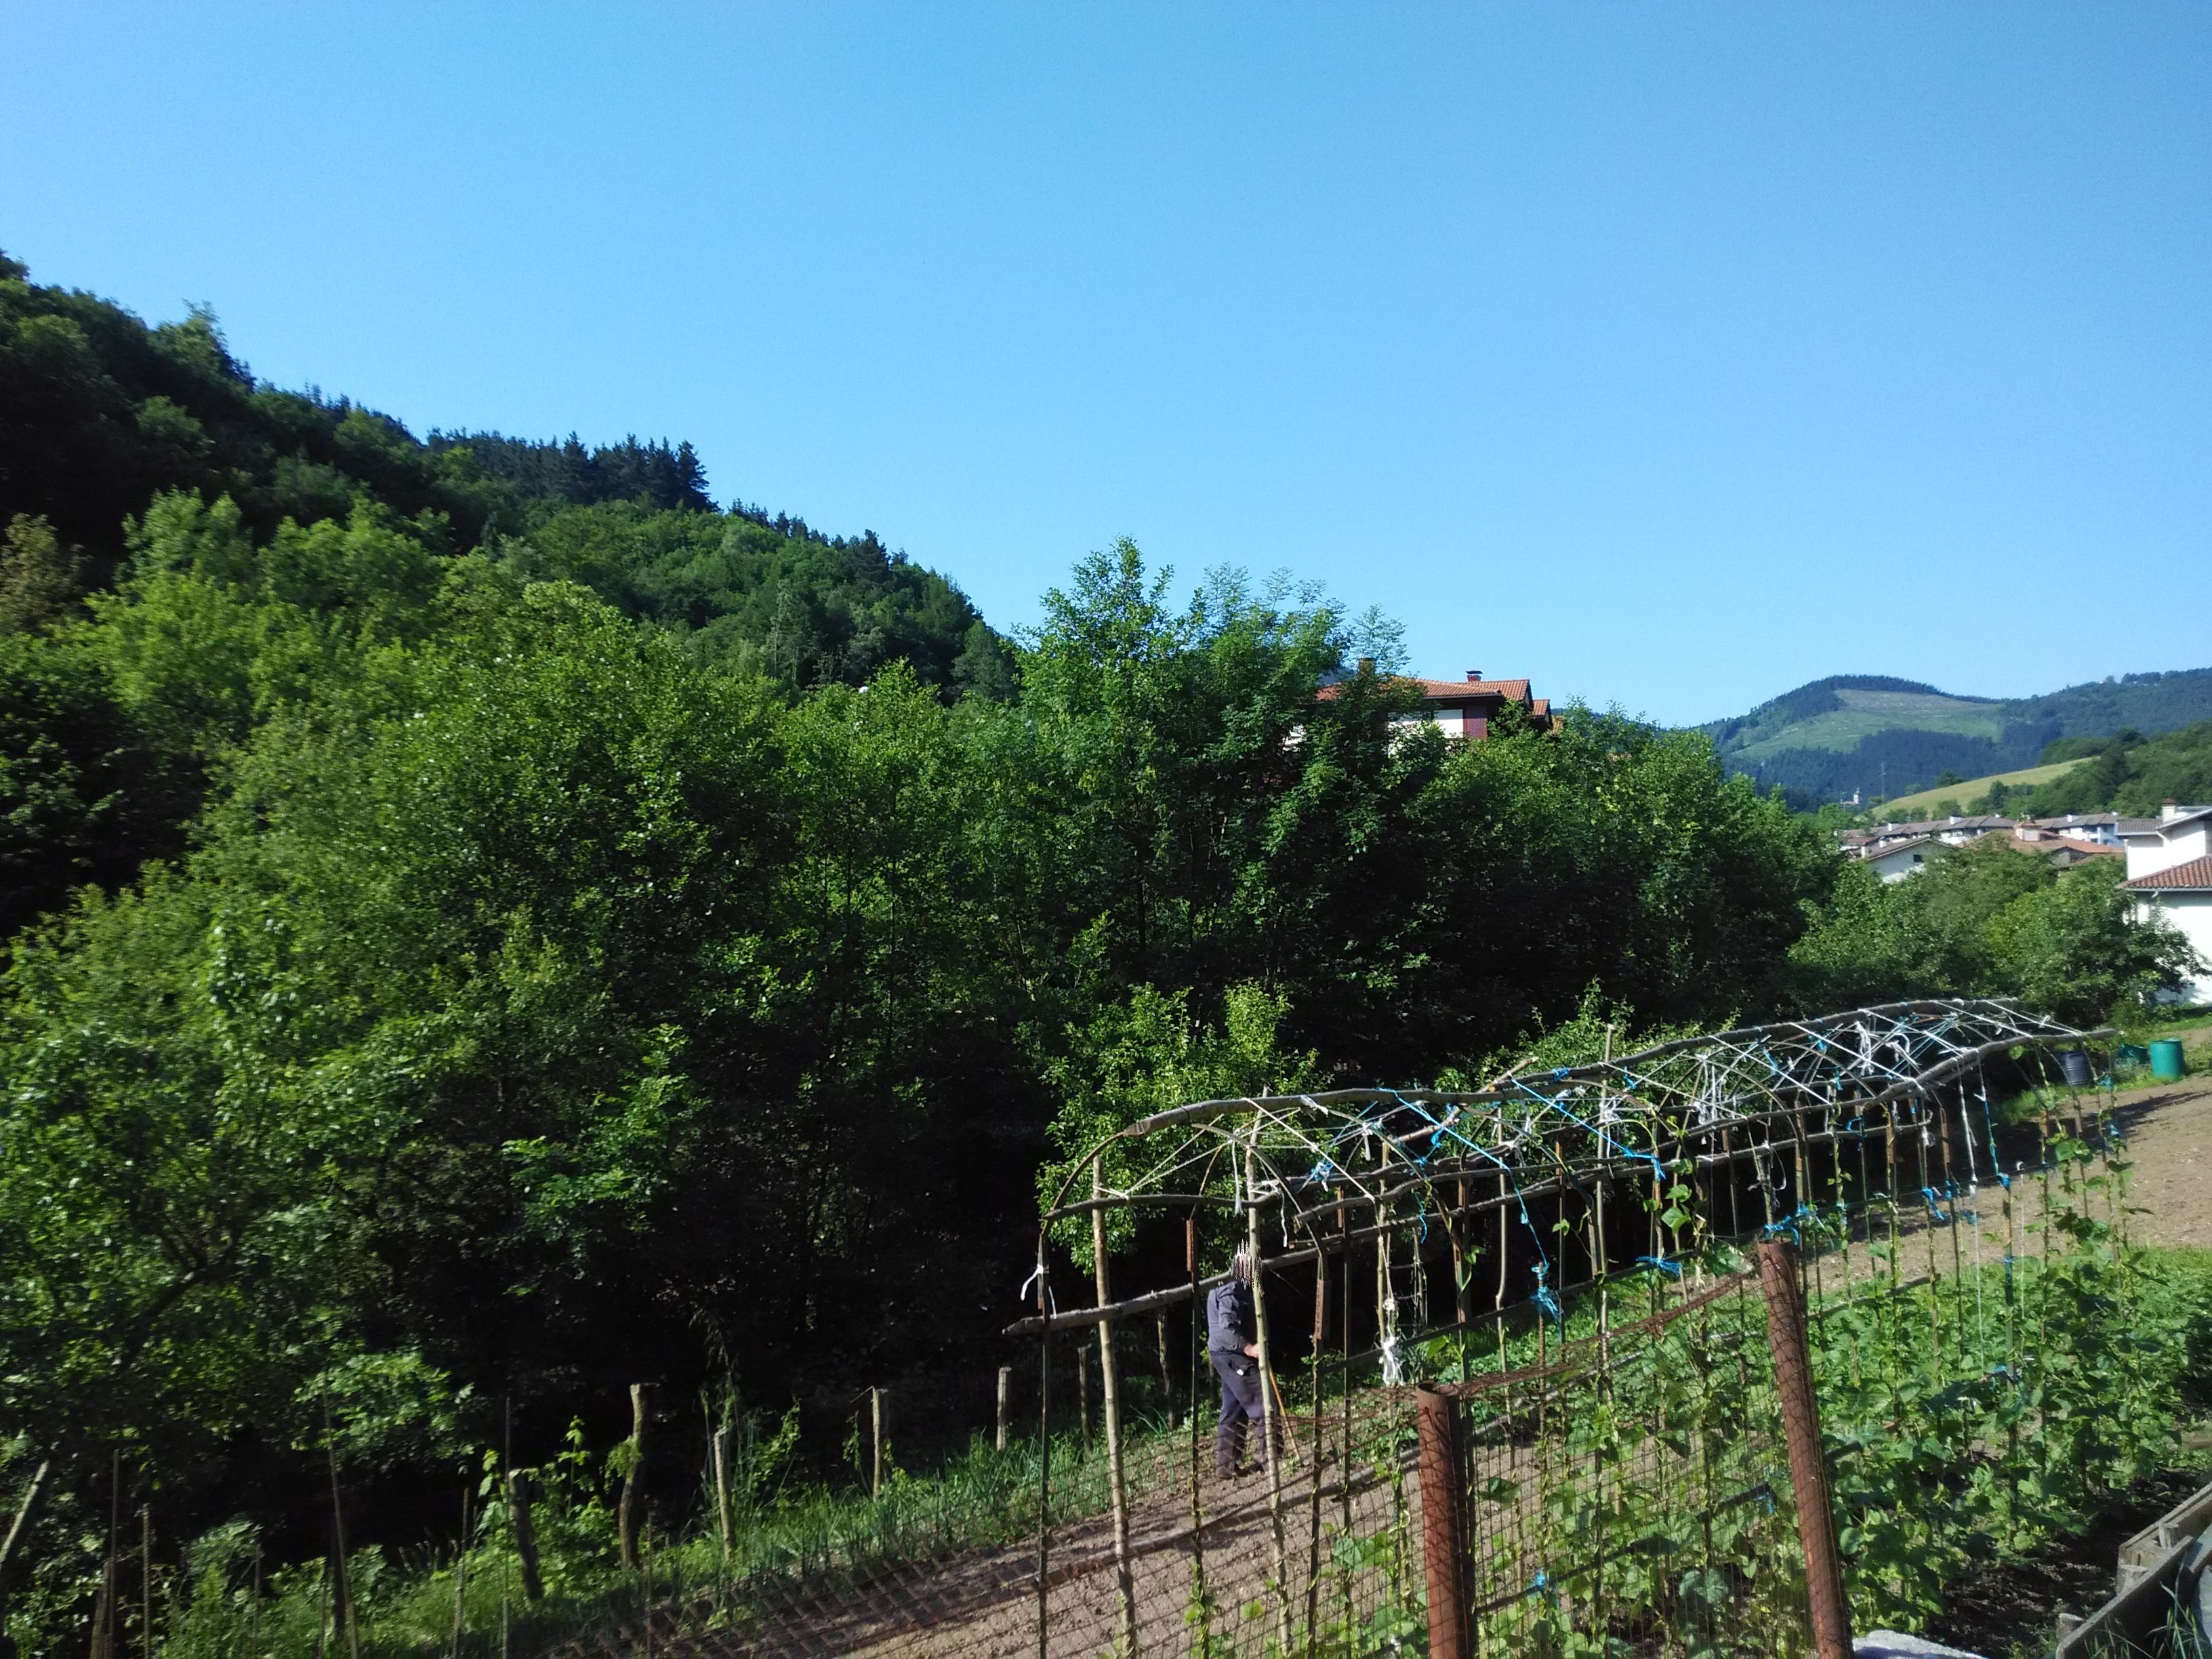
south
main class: Cropland
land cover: Apple fruit
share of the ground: 25 - 50 %
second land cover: Grassland without tree/shrub cover
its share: > 75 %
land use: Agriculture (excluding fallow land and kitchen gardens)
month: June
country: ES
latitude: 43.0547
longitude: -2.5628
